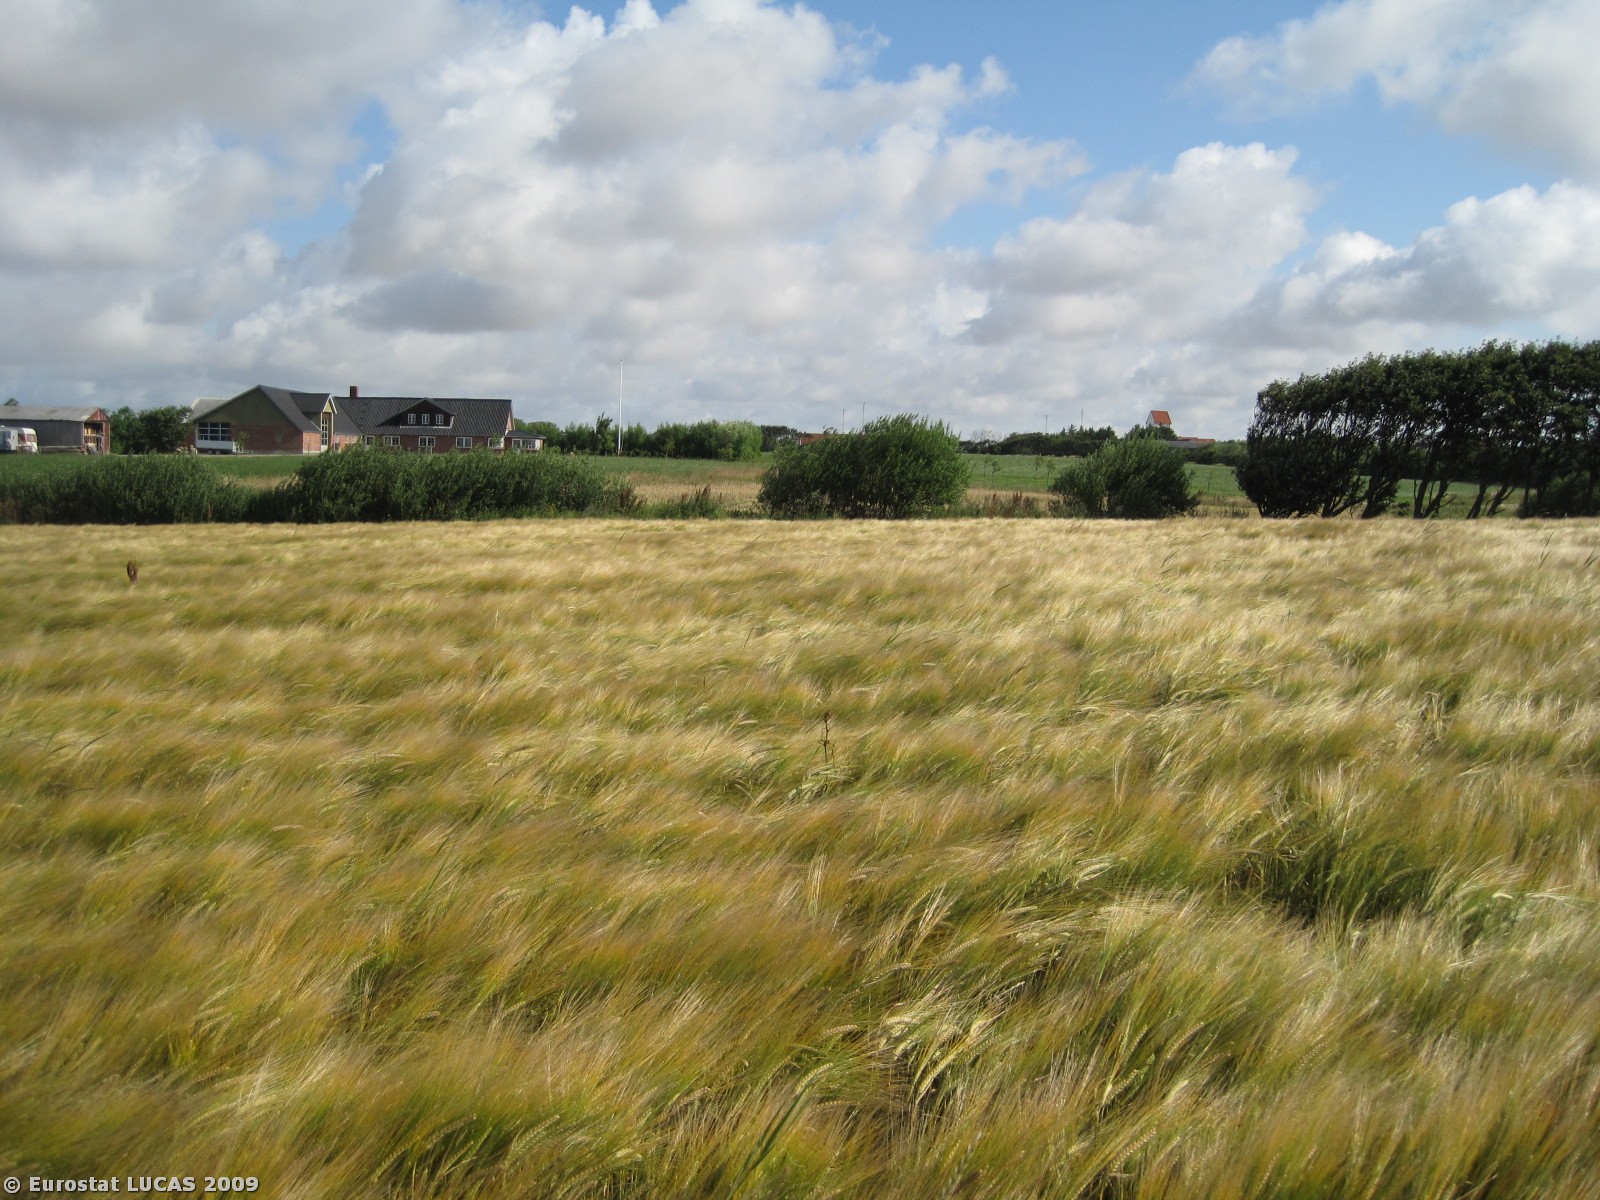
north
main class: Cropland
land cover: Barley
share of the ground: > 75 %
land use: Agriculture (excluding fallow land and kitchen gardens)
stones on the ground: < 10 %
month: July
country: DK
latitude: 56.7166
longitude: 8.3519
